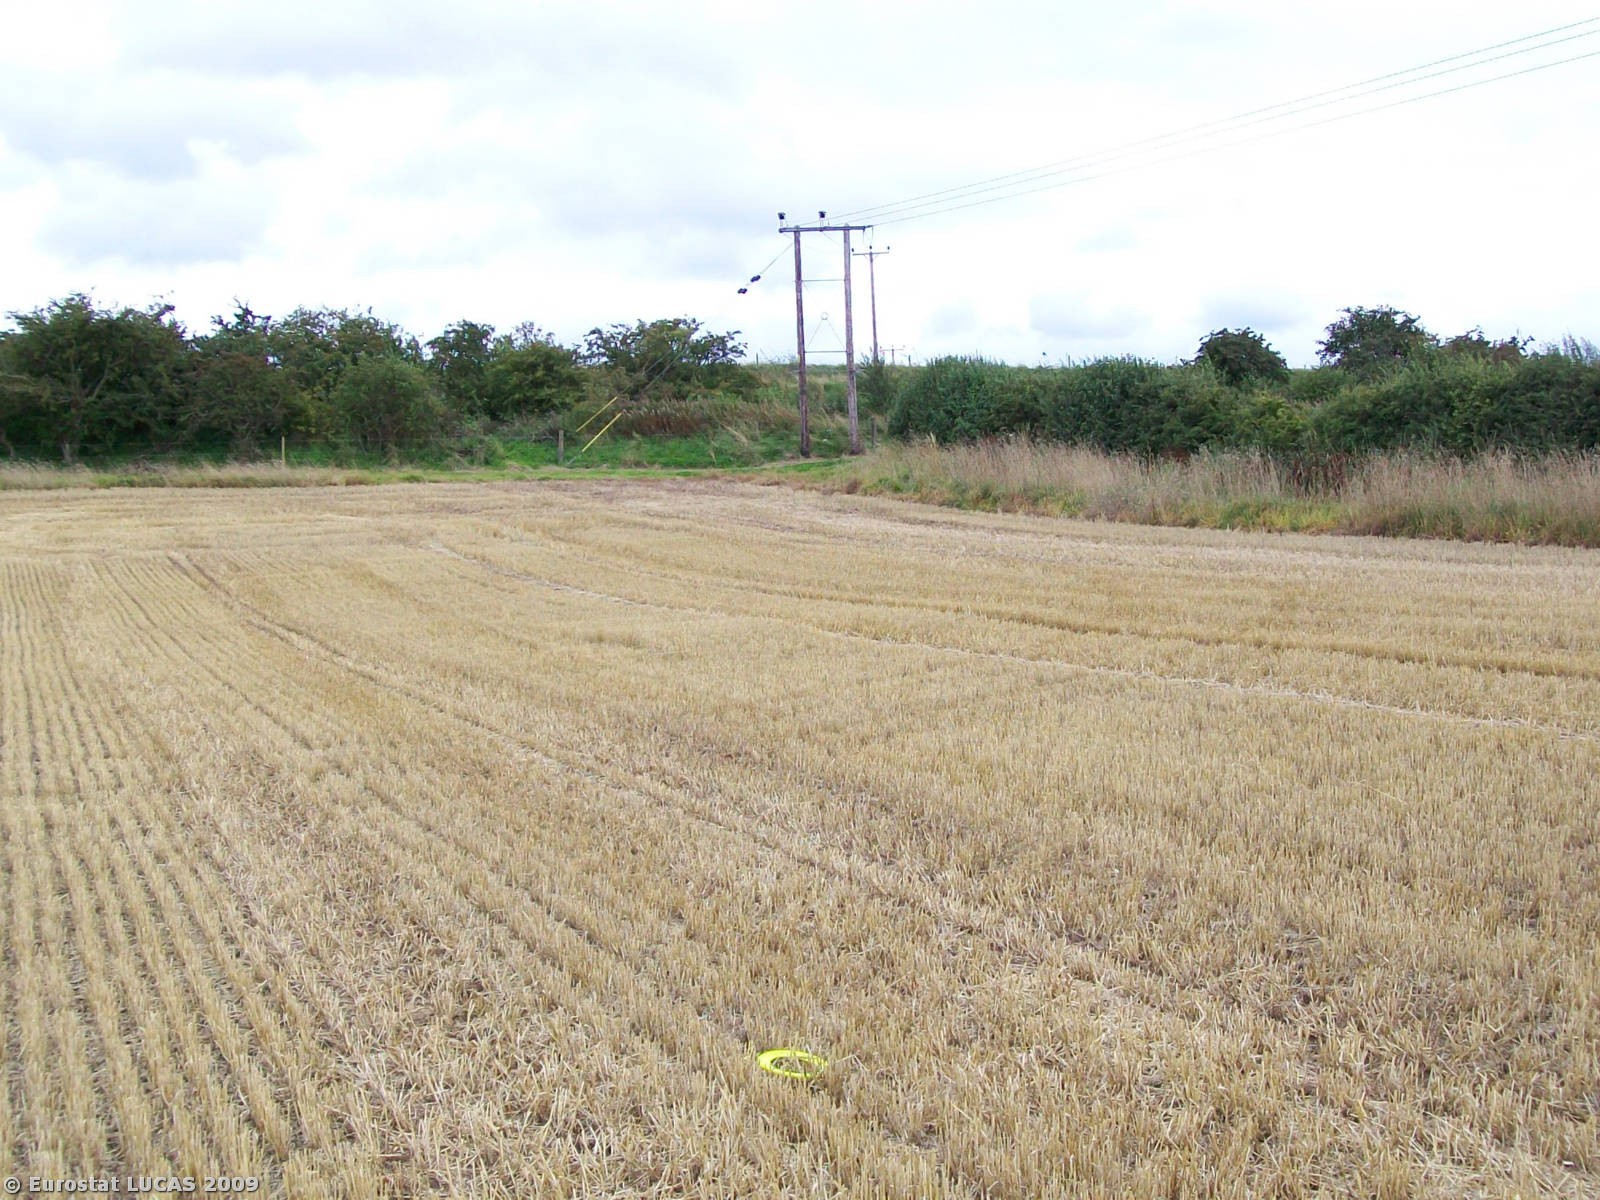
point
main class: Cropland
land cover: Barley
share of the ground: > 75 %
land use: Agriculture (excluding fallow land and kitchen gardens)
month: August
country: GB
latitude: 55.6324
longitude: -2.2717
